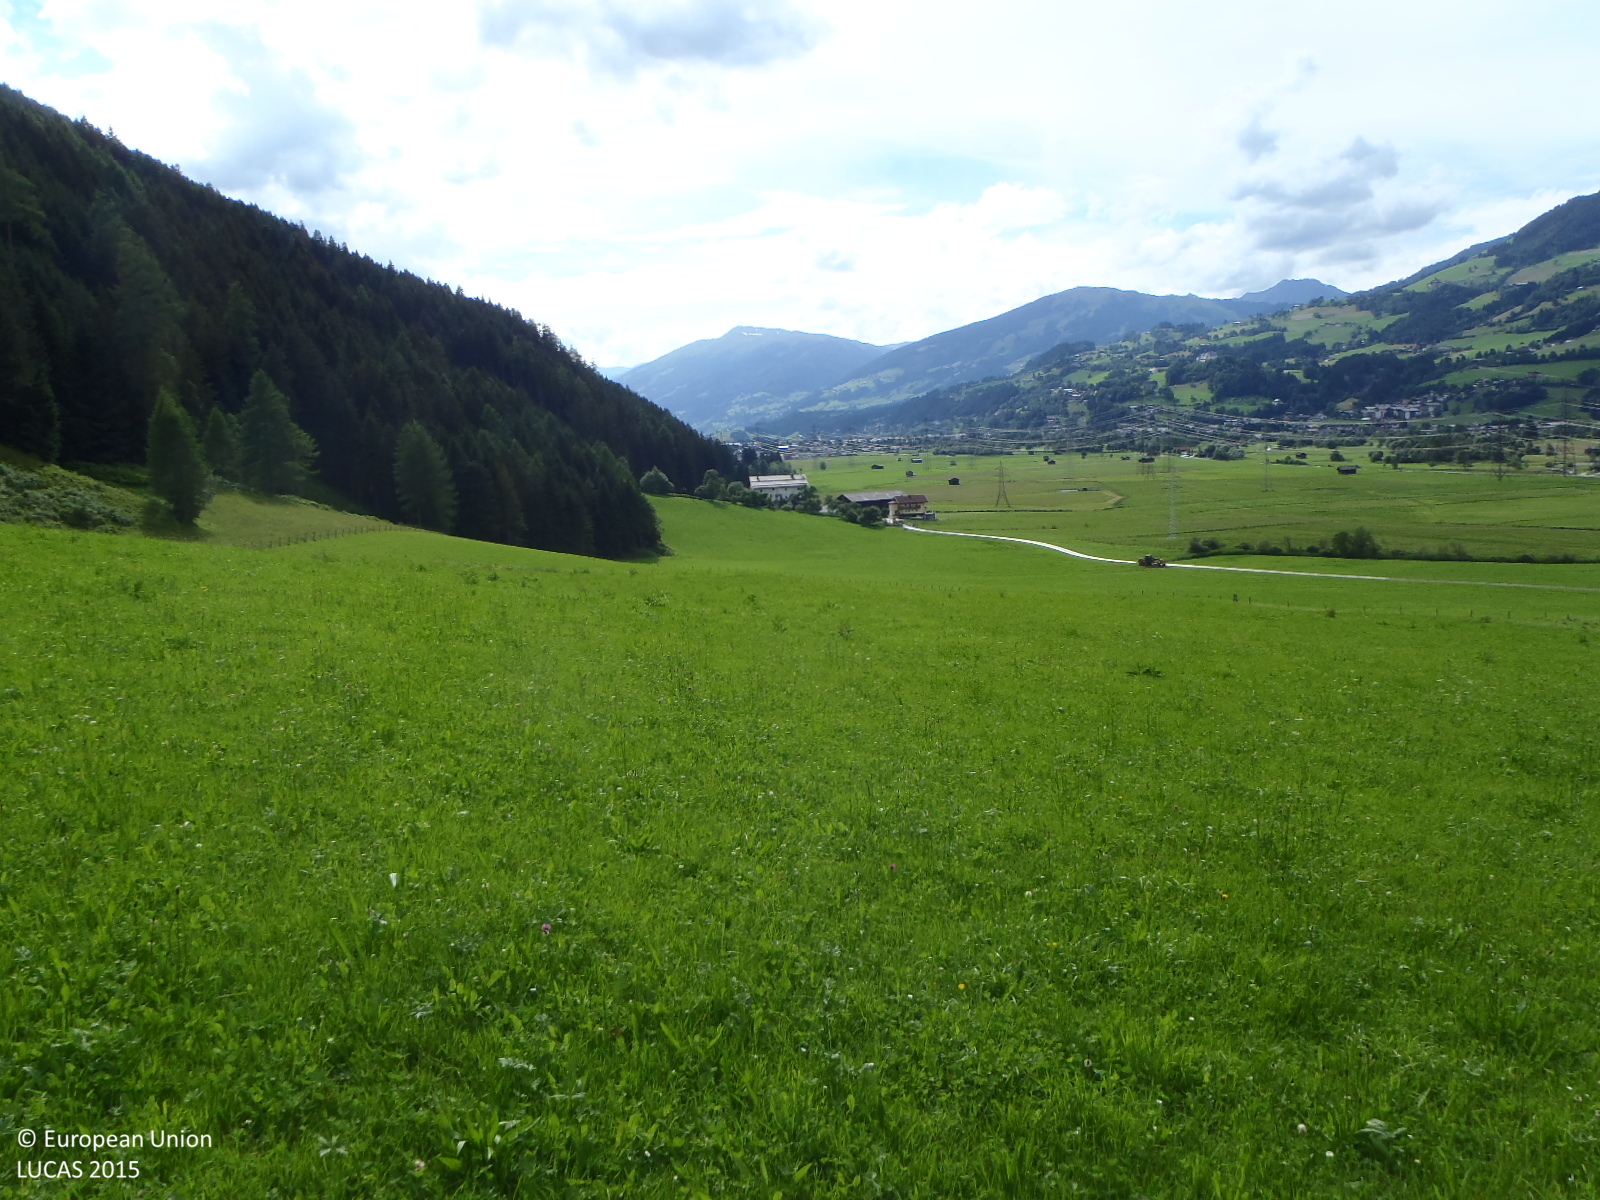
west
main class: Grassland
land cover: Grassland without tree/shrub cover
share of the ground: > 75 %
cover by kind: herbaceous plants 100 %
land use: Agriculture (excluding fallow land and kitchen gardens)
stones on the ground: < 10 %
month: June
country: AT
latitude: 47.2763
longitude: 12.5230
